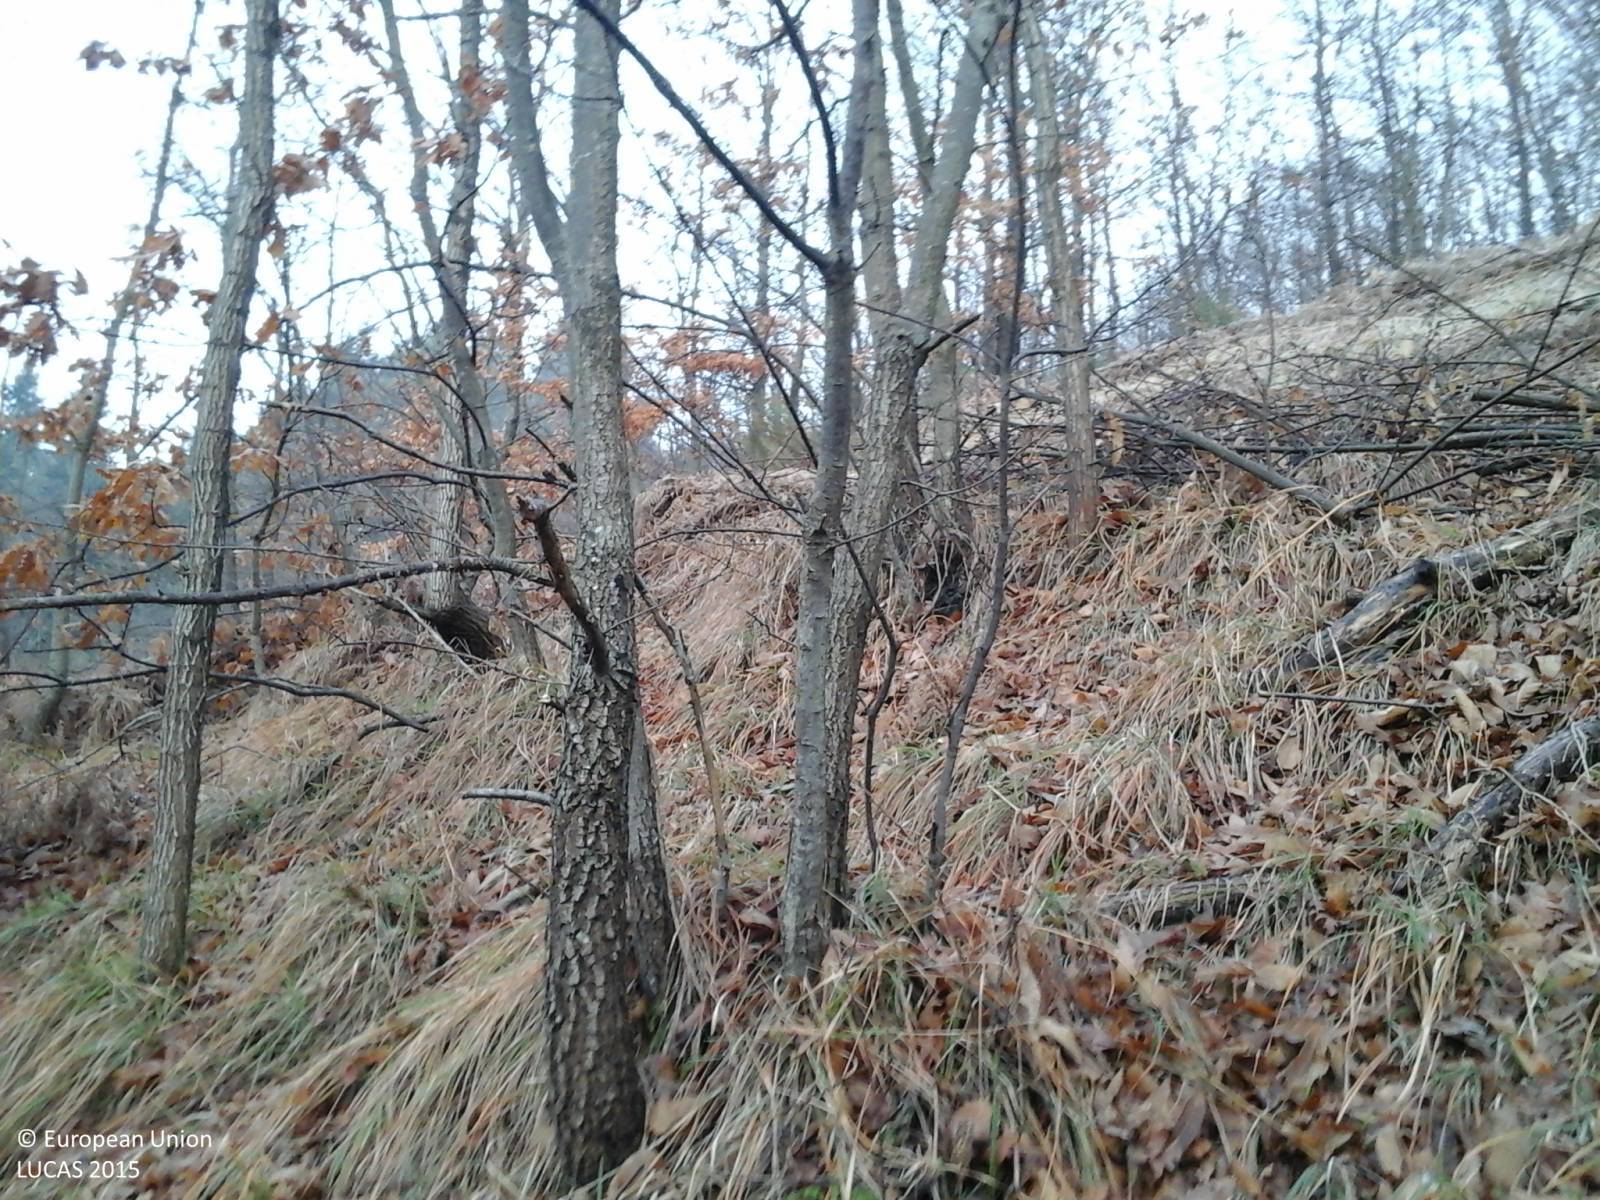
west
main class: Woodland
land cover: Broadleaved woodland
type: thermophilous deciduous forest
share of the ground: > 75 %
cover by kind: broadleaved forest trees 100 %
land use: Forestry
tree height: > 5 m
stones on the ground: 10 - 25 %
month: January
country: IT
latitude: 44.0401
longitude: 10.8838
